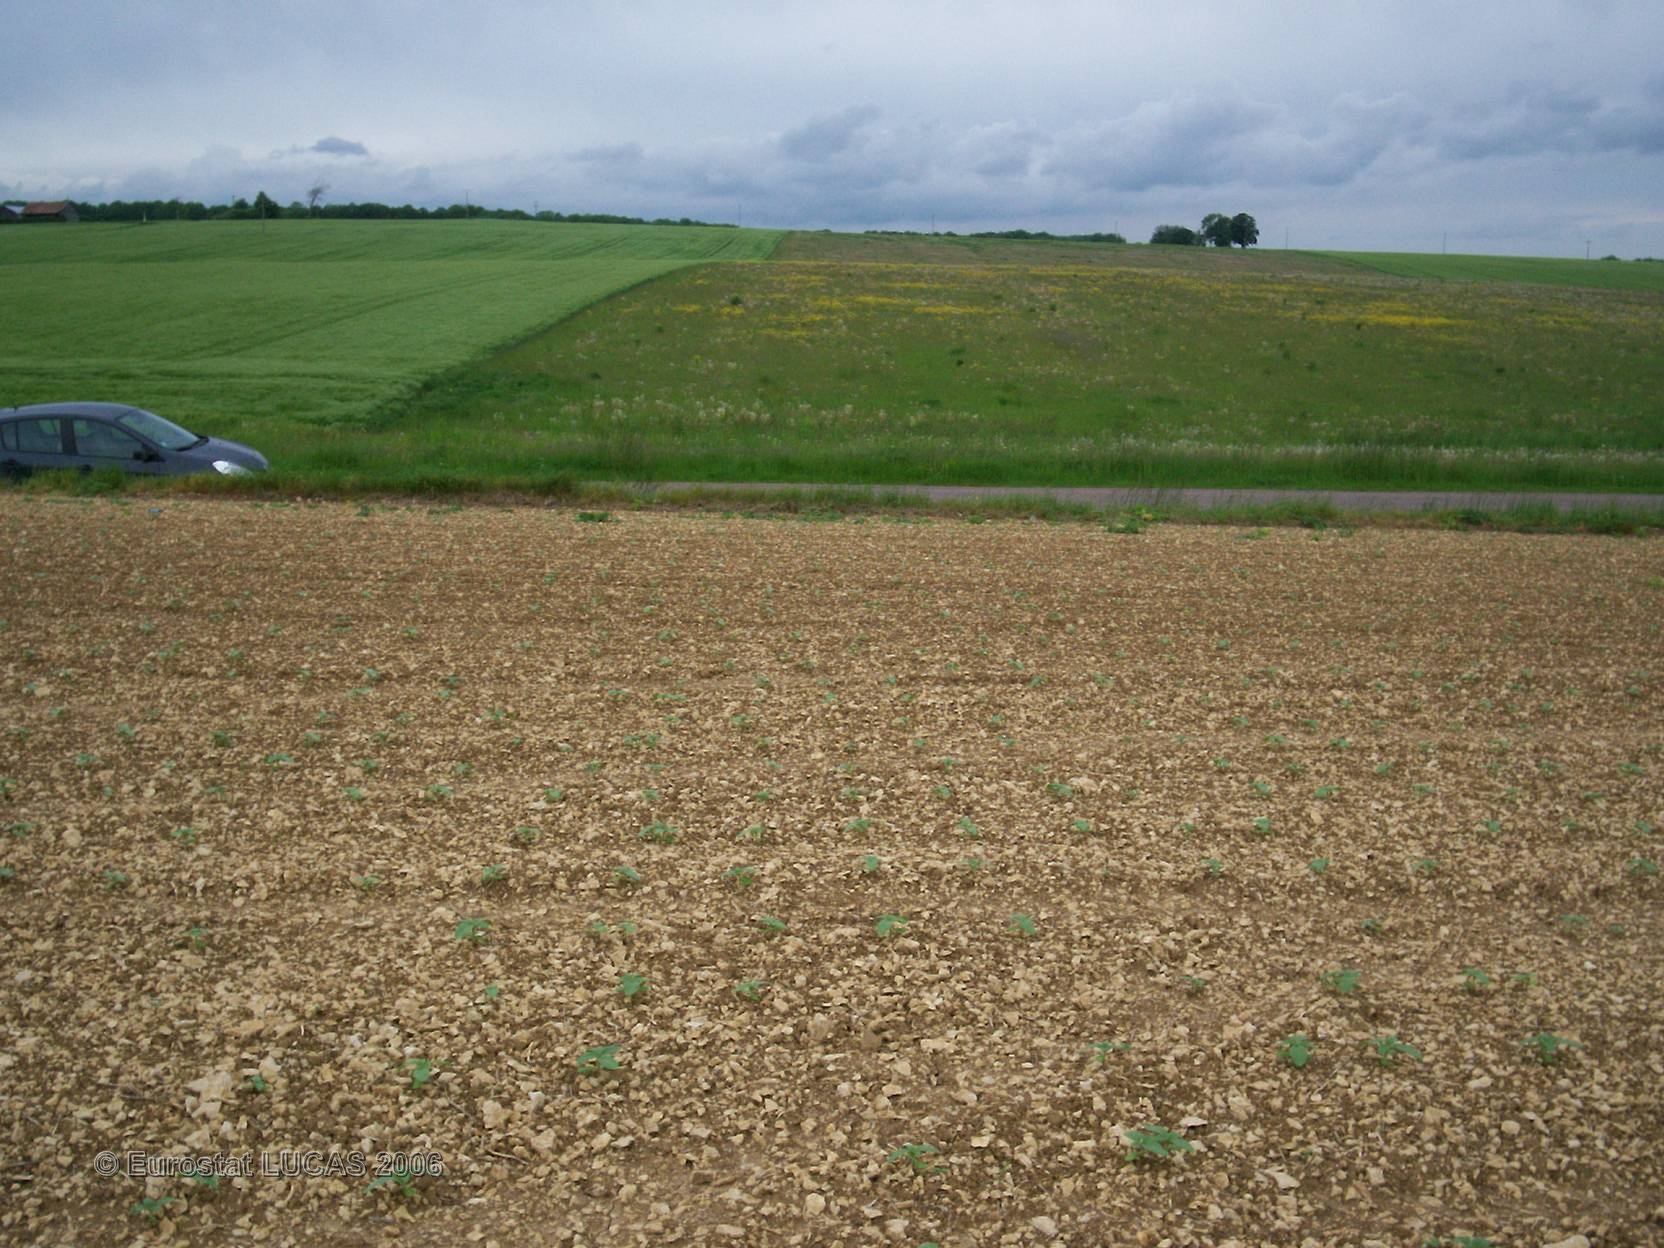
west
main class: Cropland
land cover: Sunflower
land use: Agriculture (excluding fallow land and kitchen gardens)
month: May
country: FR
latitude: 48.2109
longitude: 4.4666
